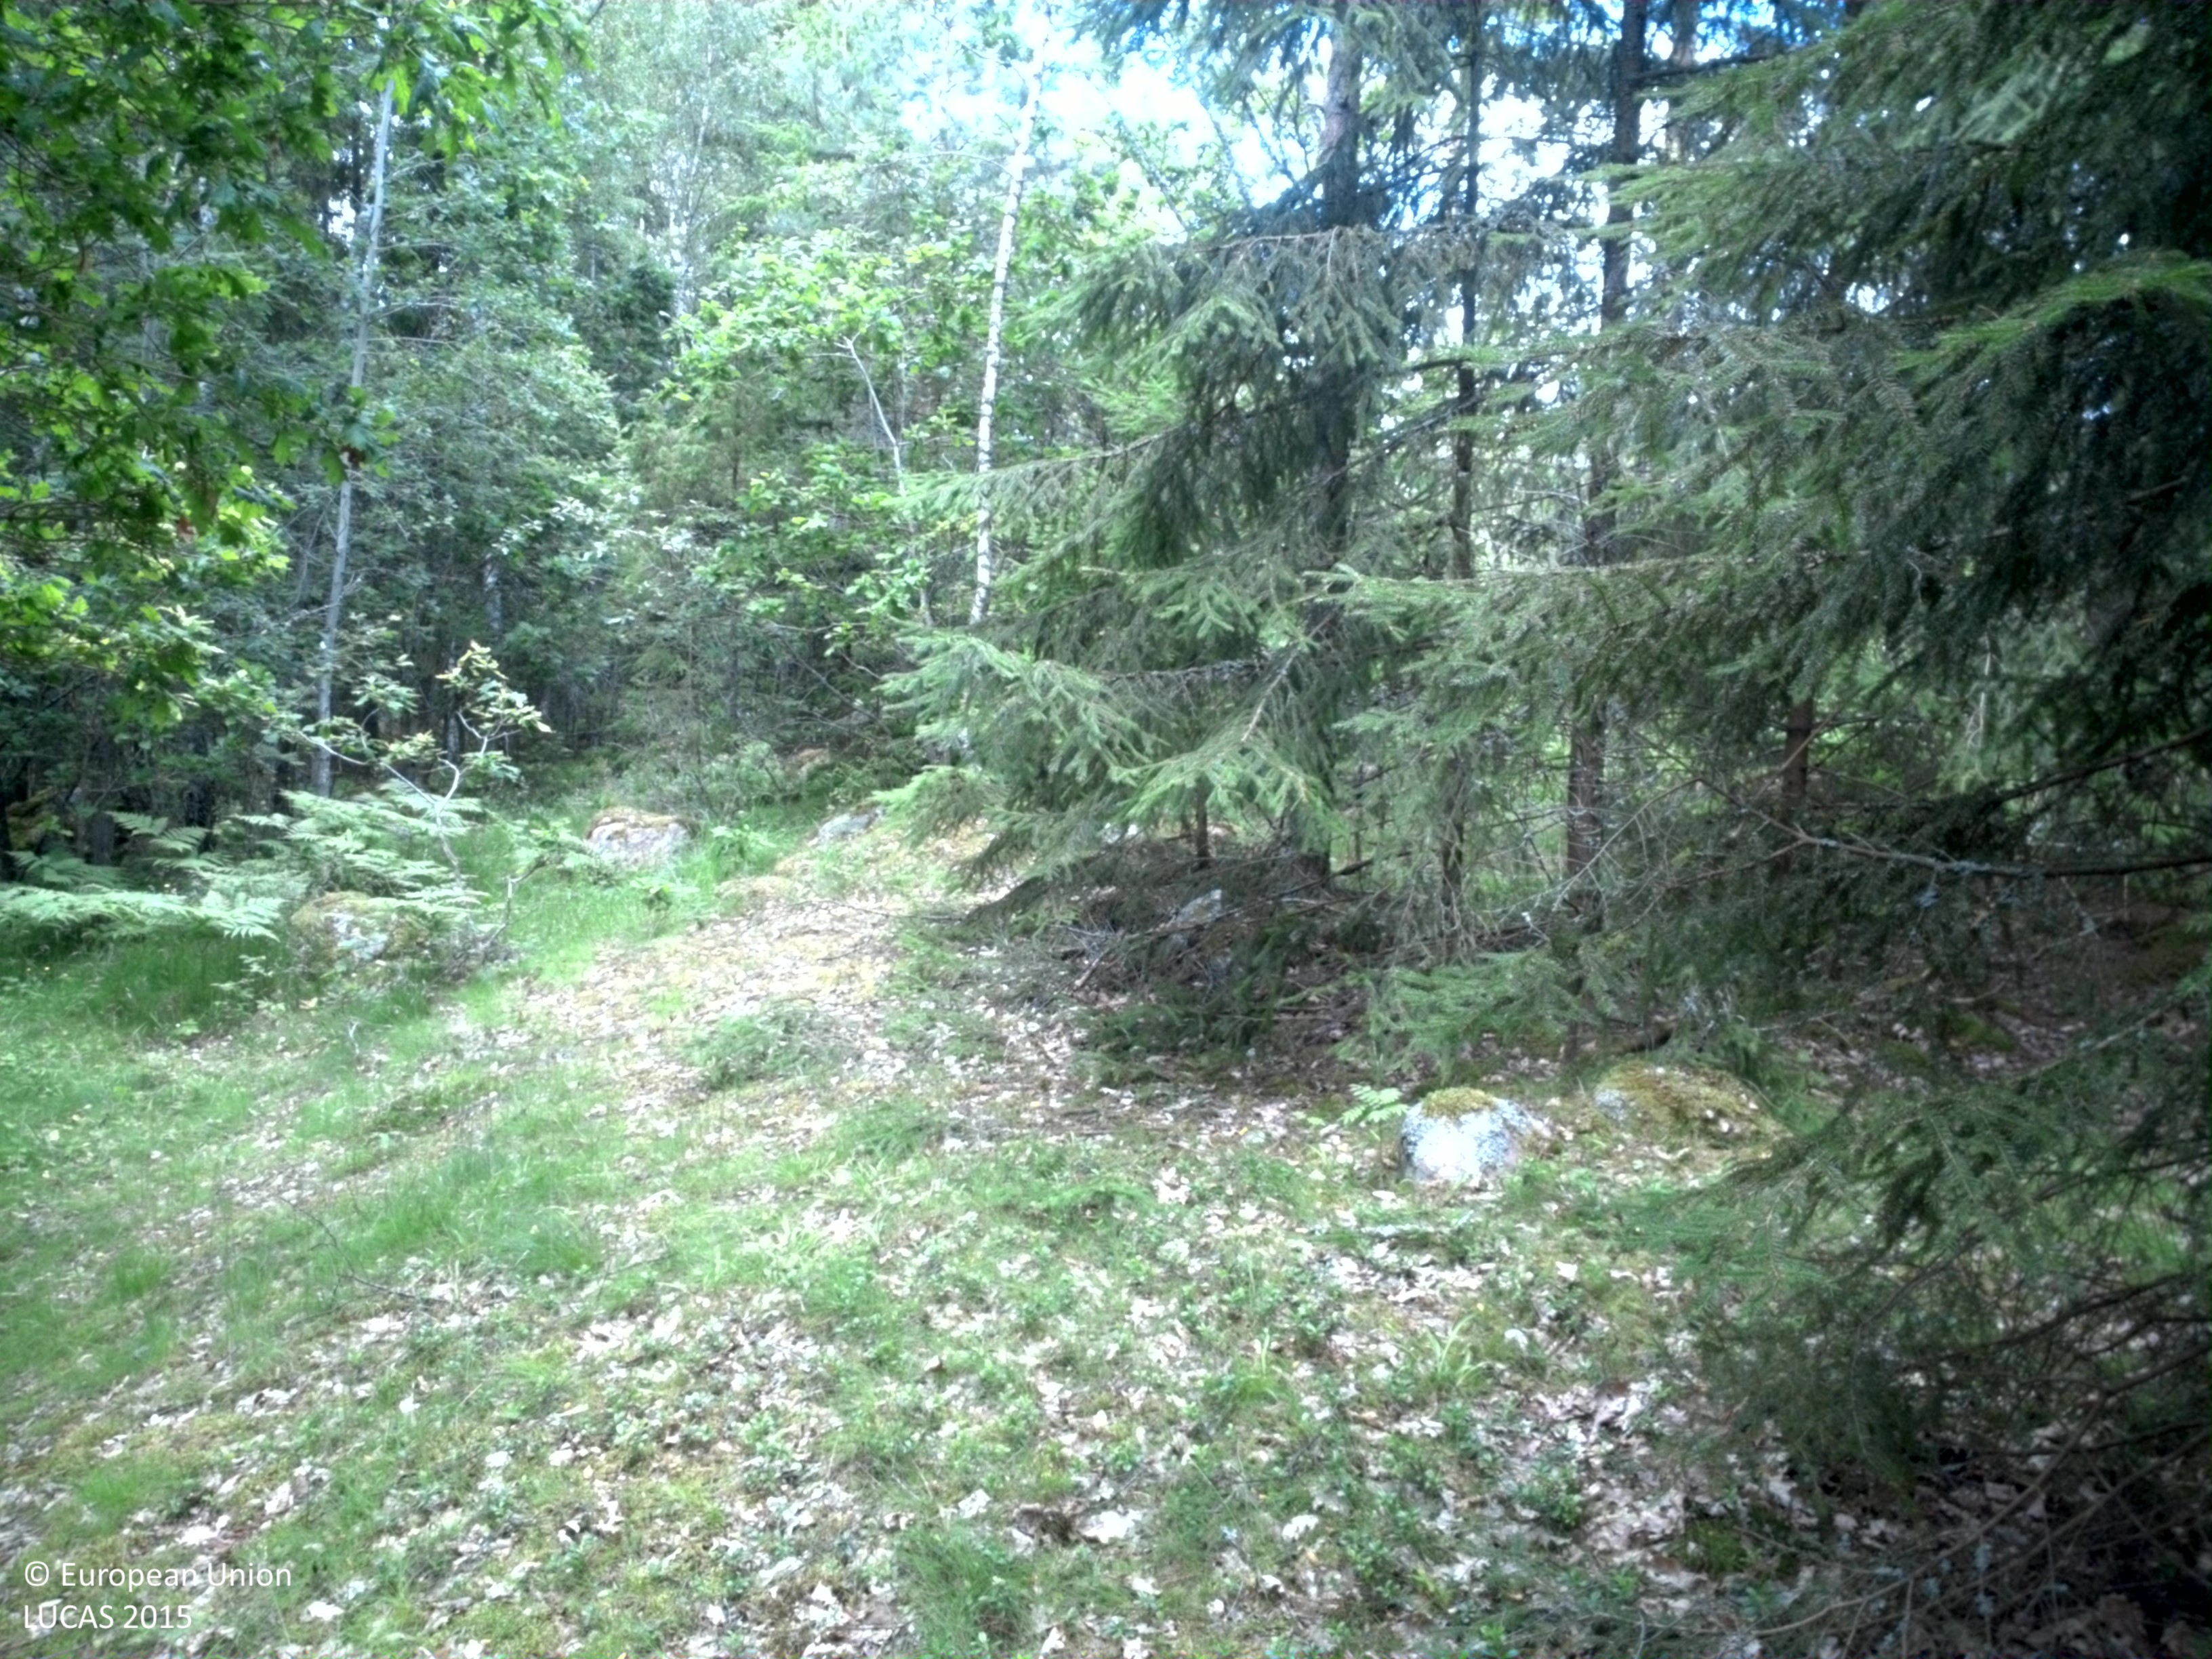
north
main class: Woodland
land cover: Spruce dominated mixed woodland
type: boreal forest
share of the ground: 50 - 75 %
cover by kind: coniferous forest trees 40 %, herbaceous plants 30 %, broadleaved forest trees 20 %, lichens and mosses 10 %
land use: Forestry
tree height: > 5 m
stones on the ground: < 10 %
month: June
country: SE
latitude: 58.7310
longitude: 15.6765
